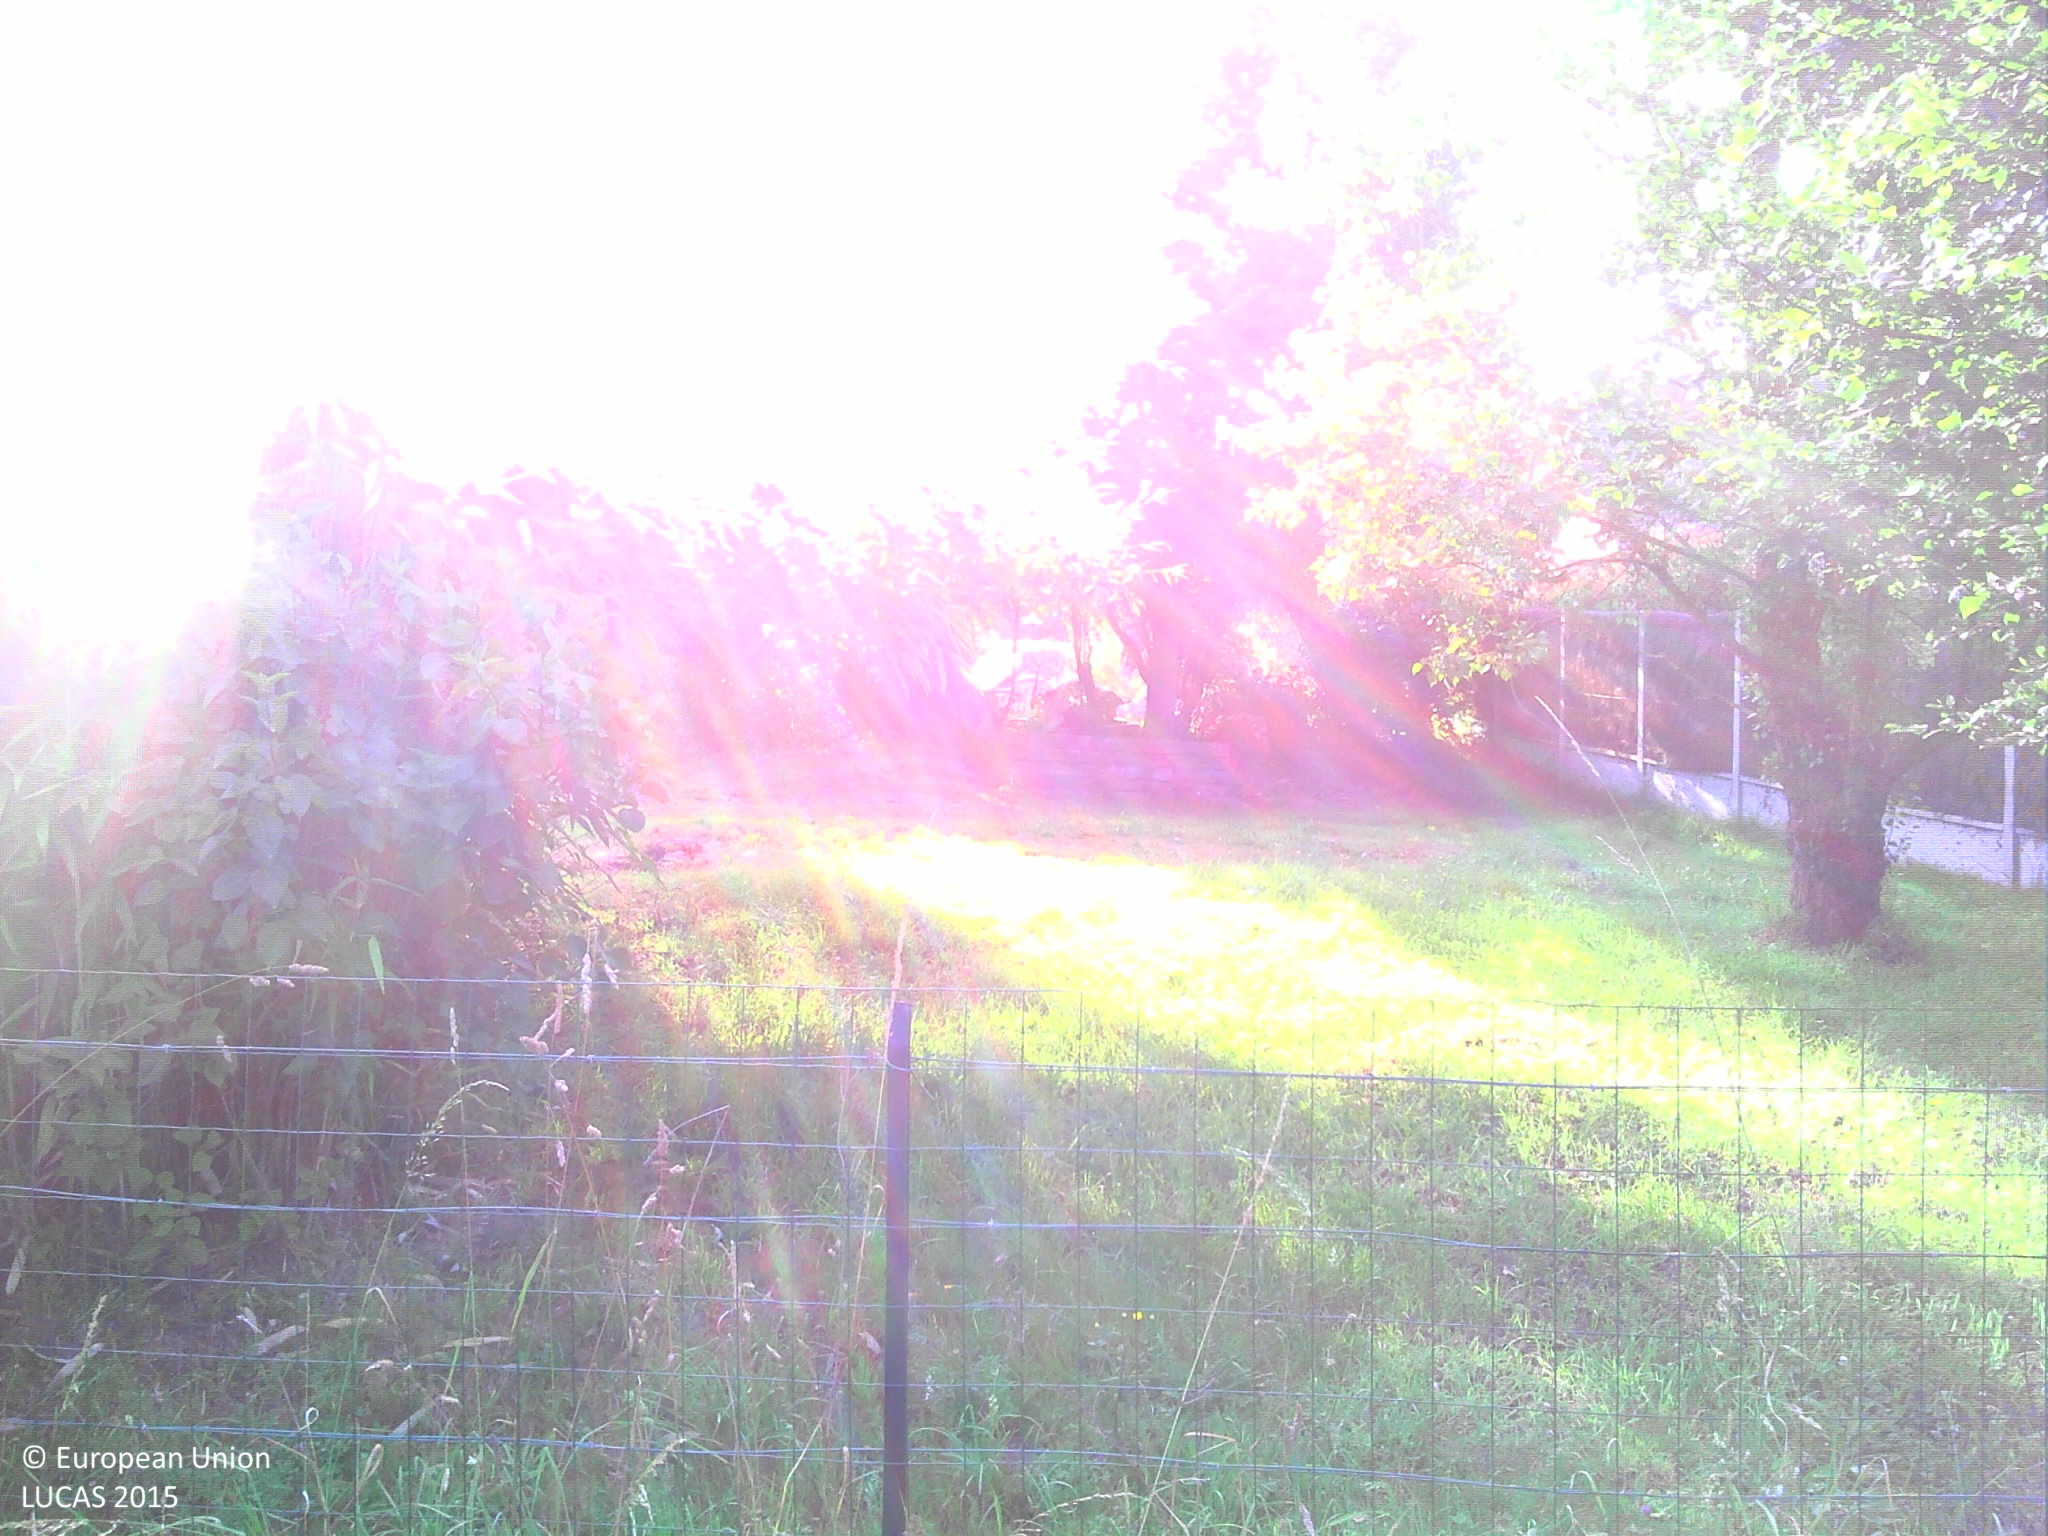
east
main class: Grassland
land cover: Grassland with sparse tree/shrub cover
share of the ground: > 75 %
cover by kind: herbaceous plants 95 %, broadleaved forest trees 5 %
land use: Residential
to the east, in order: Grassland with sparse tree/shrub cover; Broadleaved woodland; Temporary grasslands; Electric lines; Temporary grasslands; Electric lines; Broadleaved woodland; Fences; Tracks; Broadleaved woodland; Tracks; Shrubland with sparse tree cover; Abandoned hedges; Grassland without tree/shrub cover
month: July
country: FR
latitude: 47.3378
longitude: -1.9191
